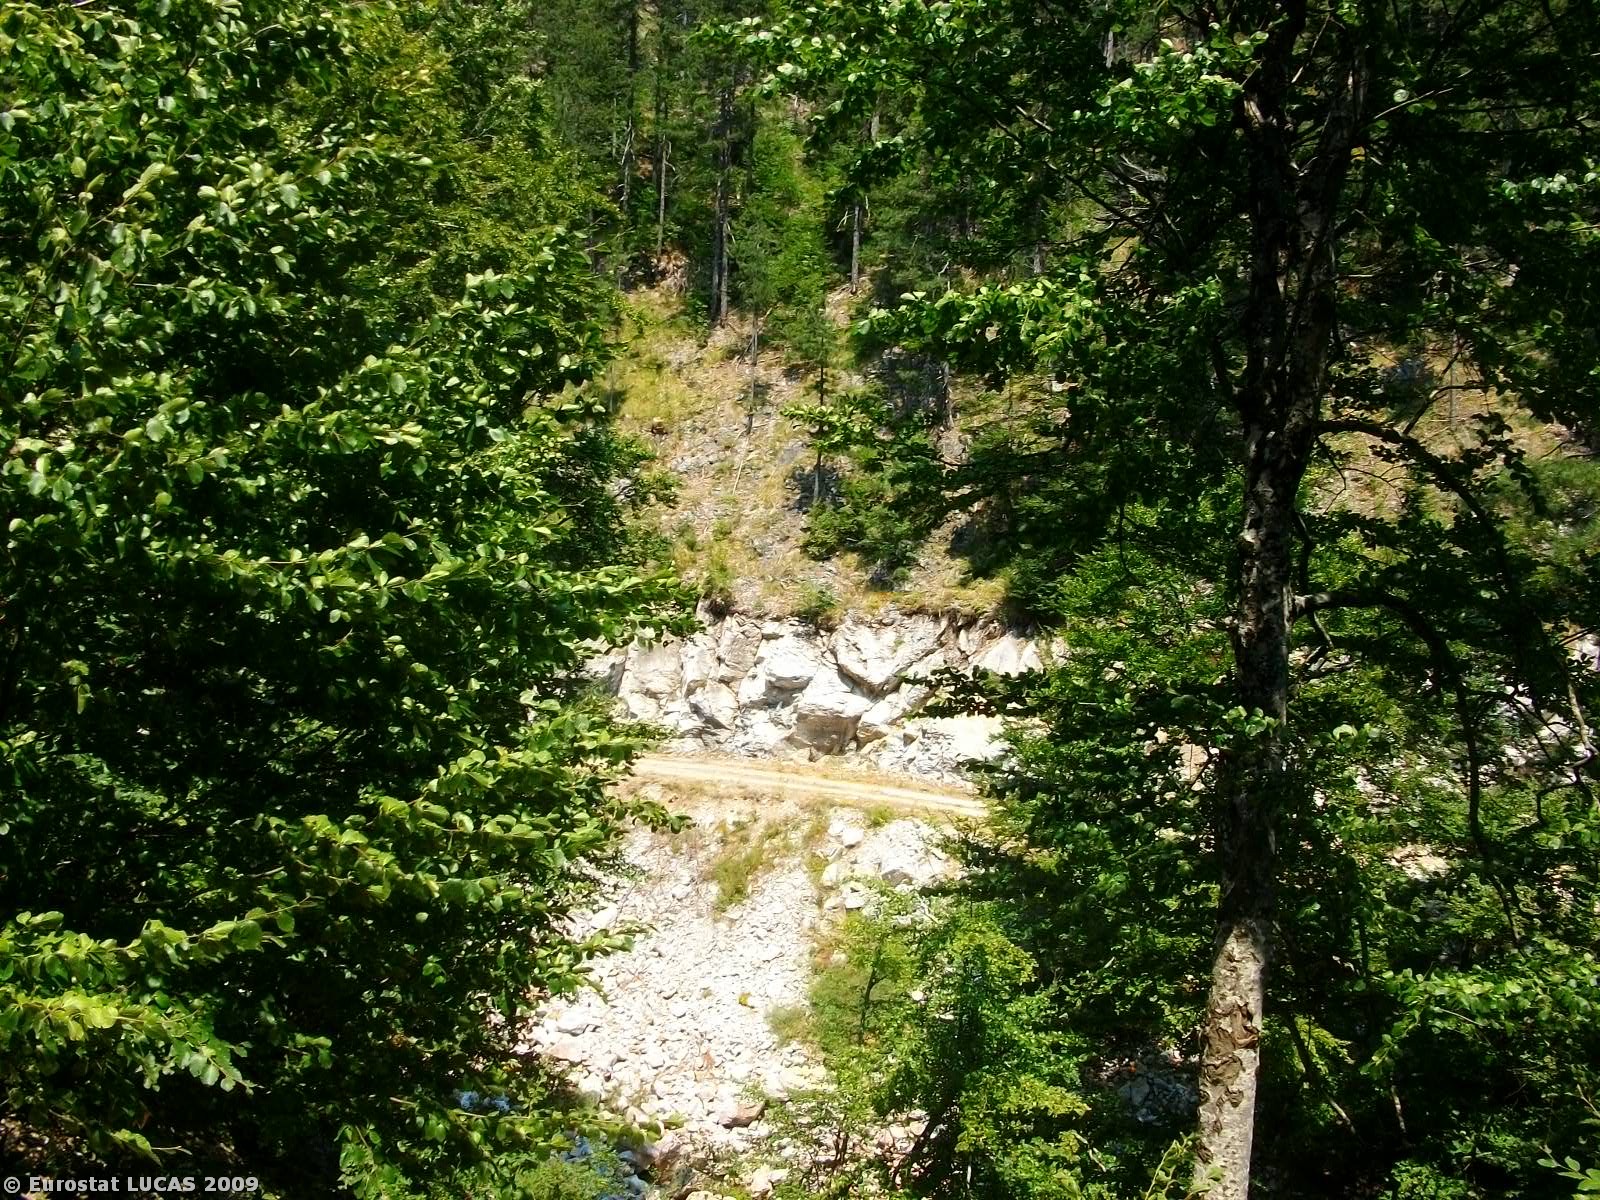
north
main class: Woodland
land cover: Mixed woodland
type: mountainous beech forest
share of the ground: > 75 %
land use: Nature reserves
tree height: > 5 m
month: July
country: GR
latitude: 40.0523
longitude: 22.4795
